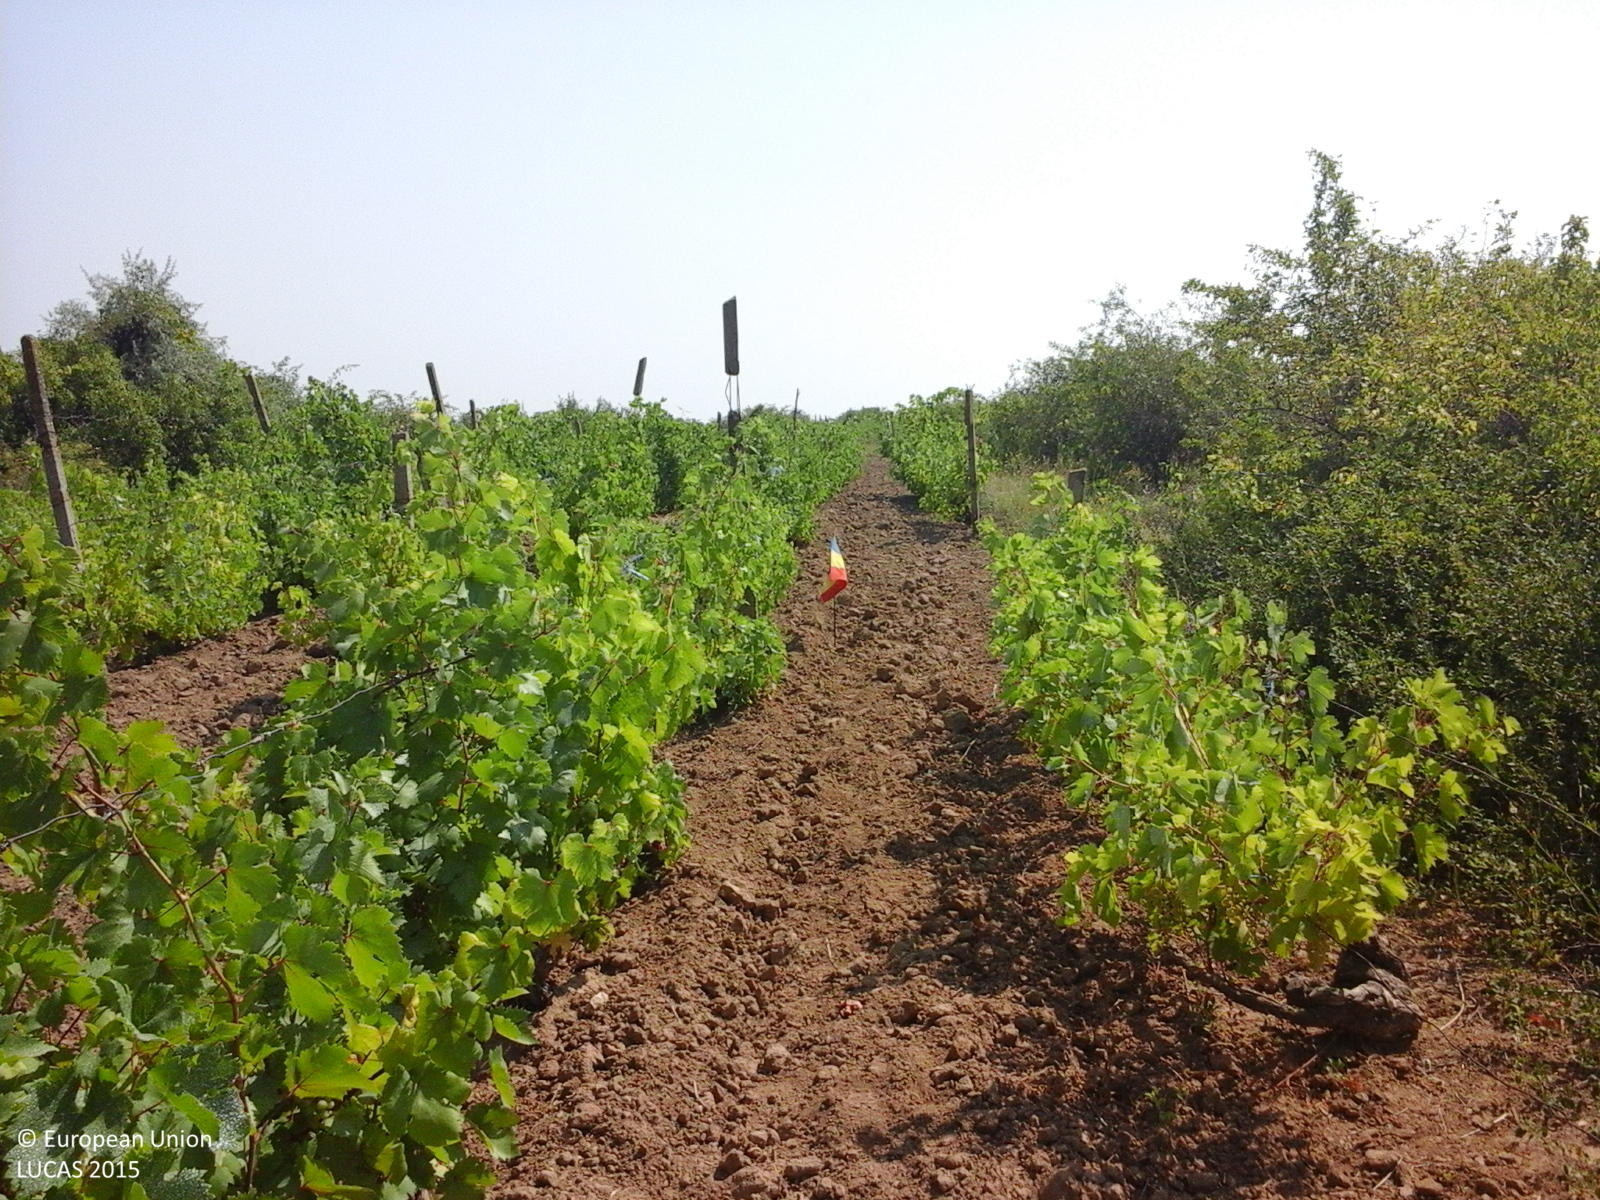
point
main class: Cropland
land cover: Vineyards
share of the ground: > 75 %
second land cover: Other bare soil
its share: > 75 %
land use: Agriculture (excluding fallow land and kitchen gardens)
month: July
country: RO
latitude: 45.6128
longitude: 27.8221
